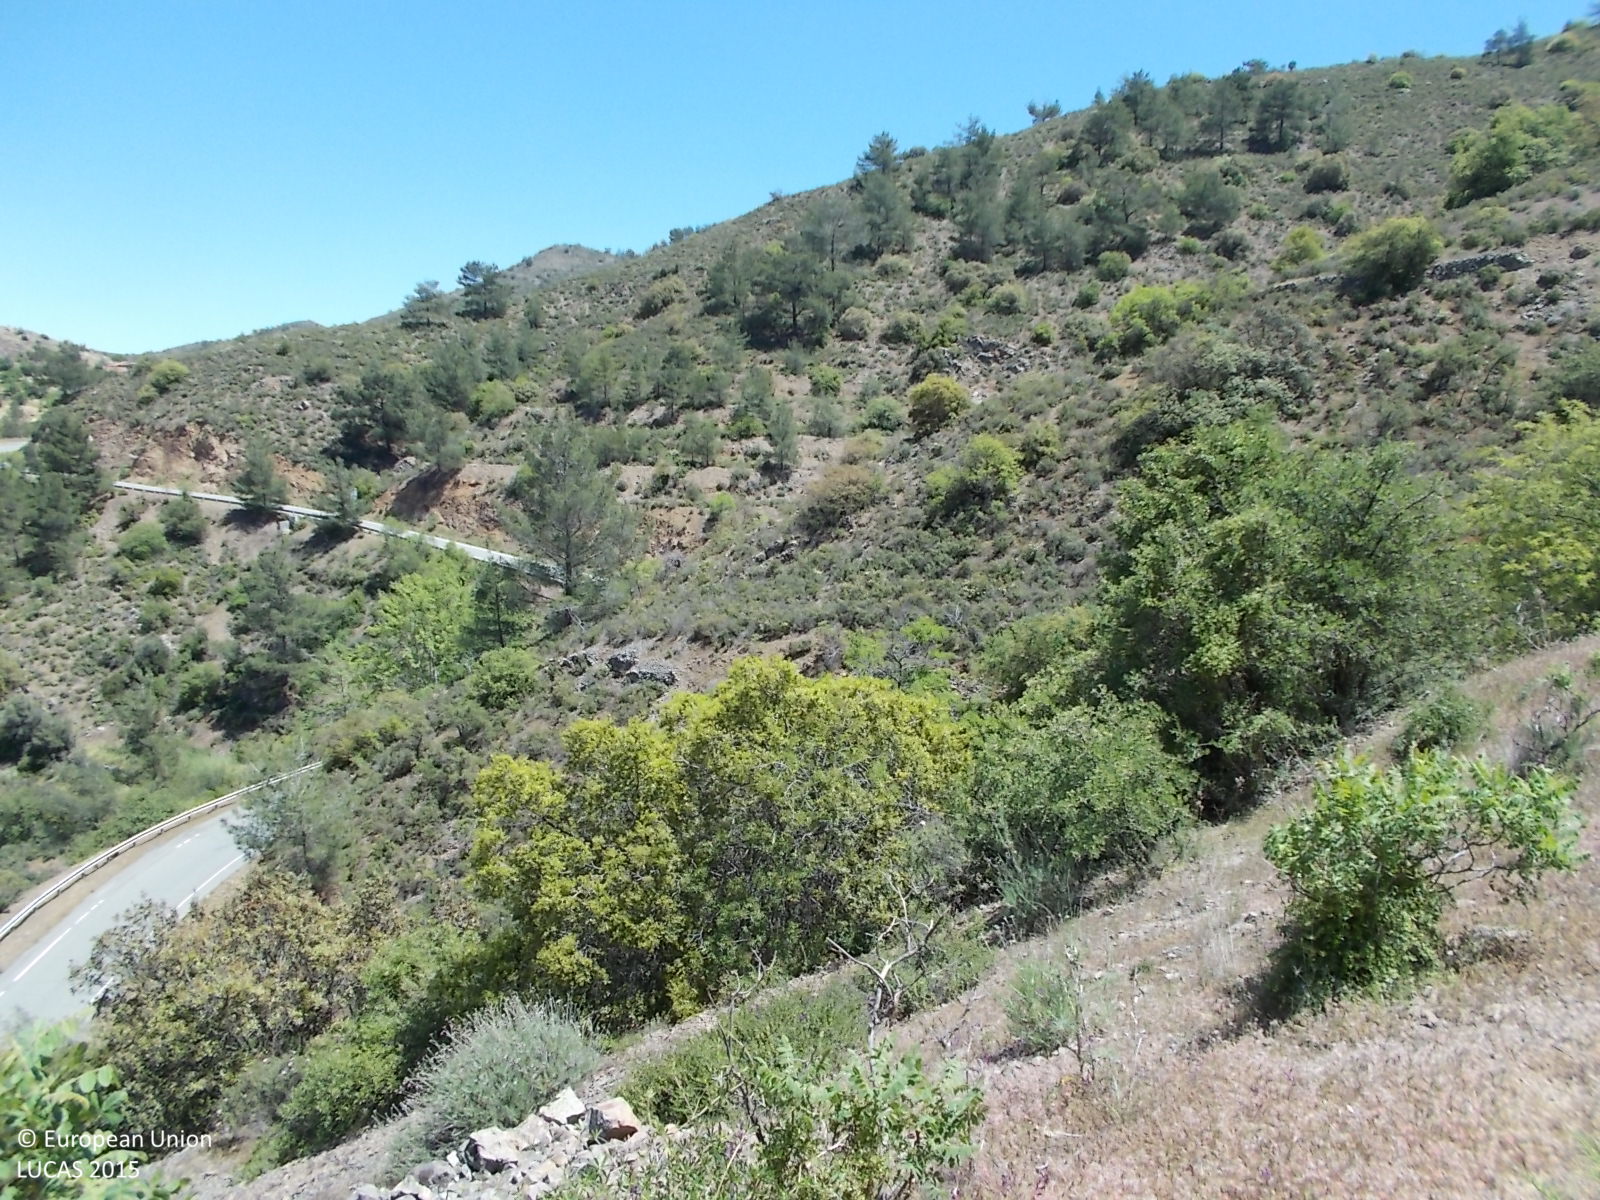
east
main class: Woodland
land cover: Other mixed woodland
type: broadleaved evergreen forest
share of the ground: 10 - 25 %
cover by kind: shrubs 30 %, herbaceous plants 30 %, unconsolidated bare surface 20 %, broadleaved forest trees 10 %, coniferous forest trees 5 %, consolidated bare surface 5 %
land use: Forestry
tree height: > 5 m
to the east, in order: Other mixed woodland; Rivers and streams; Shrubland with sparse tree cover; Rivers and streams; Paved roads, cycling and walking lanes; Shrubland with sparse tree cover; Pine dominated coniferous woodland; Rivers and streams; Shrubland with sparse tree cover
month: May
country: CY
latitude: 34.9579
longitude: 33.1654
